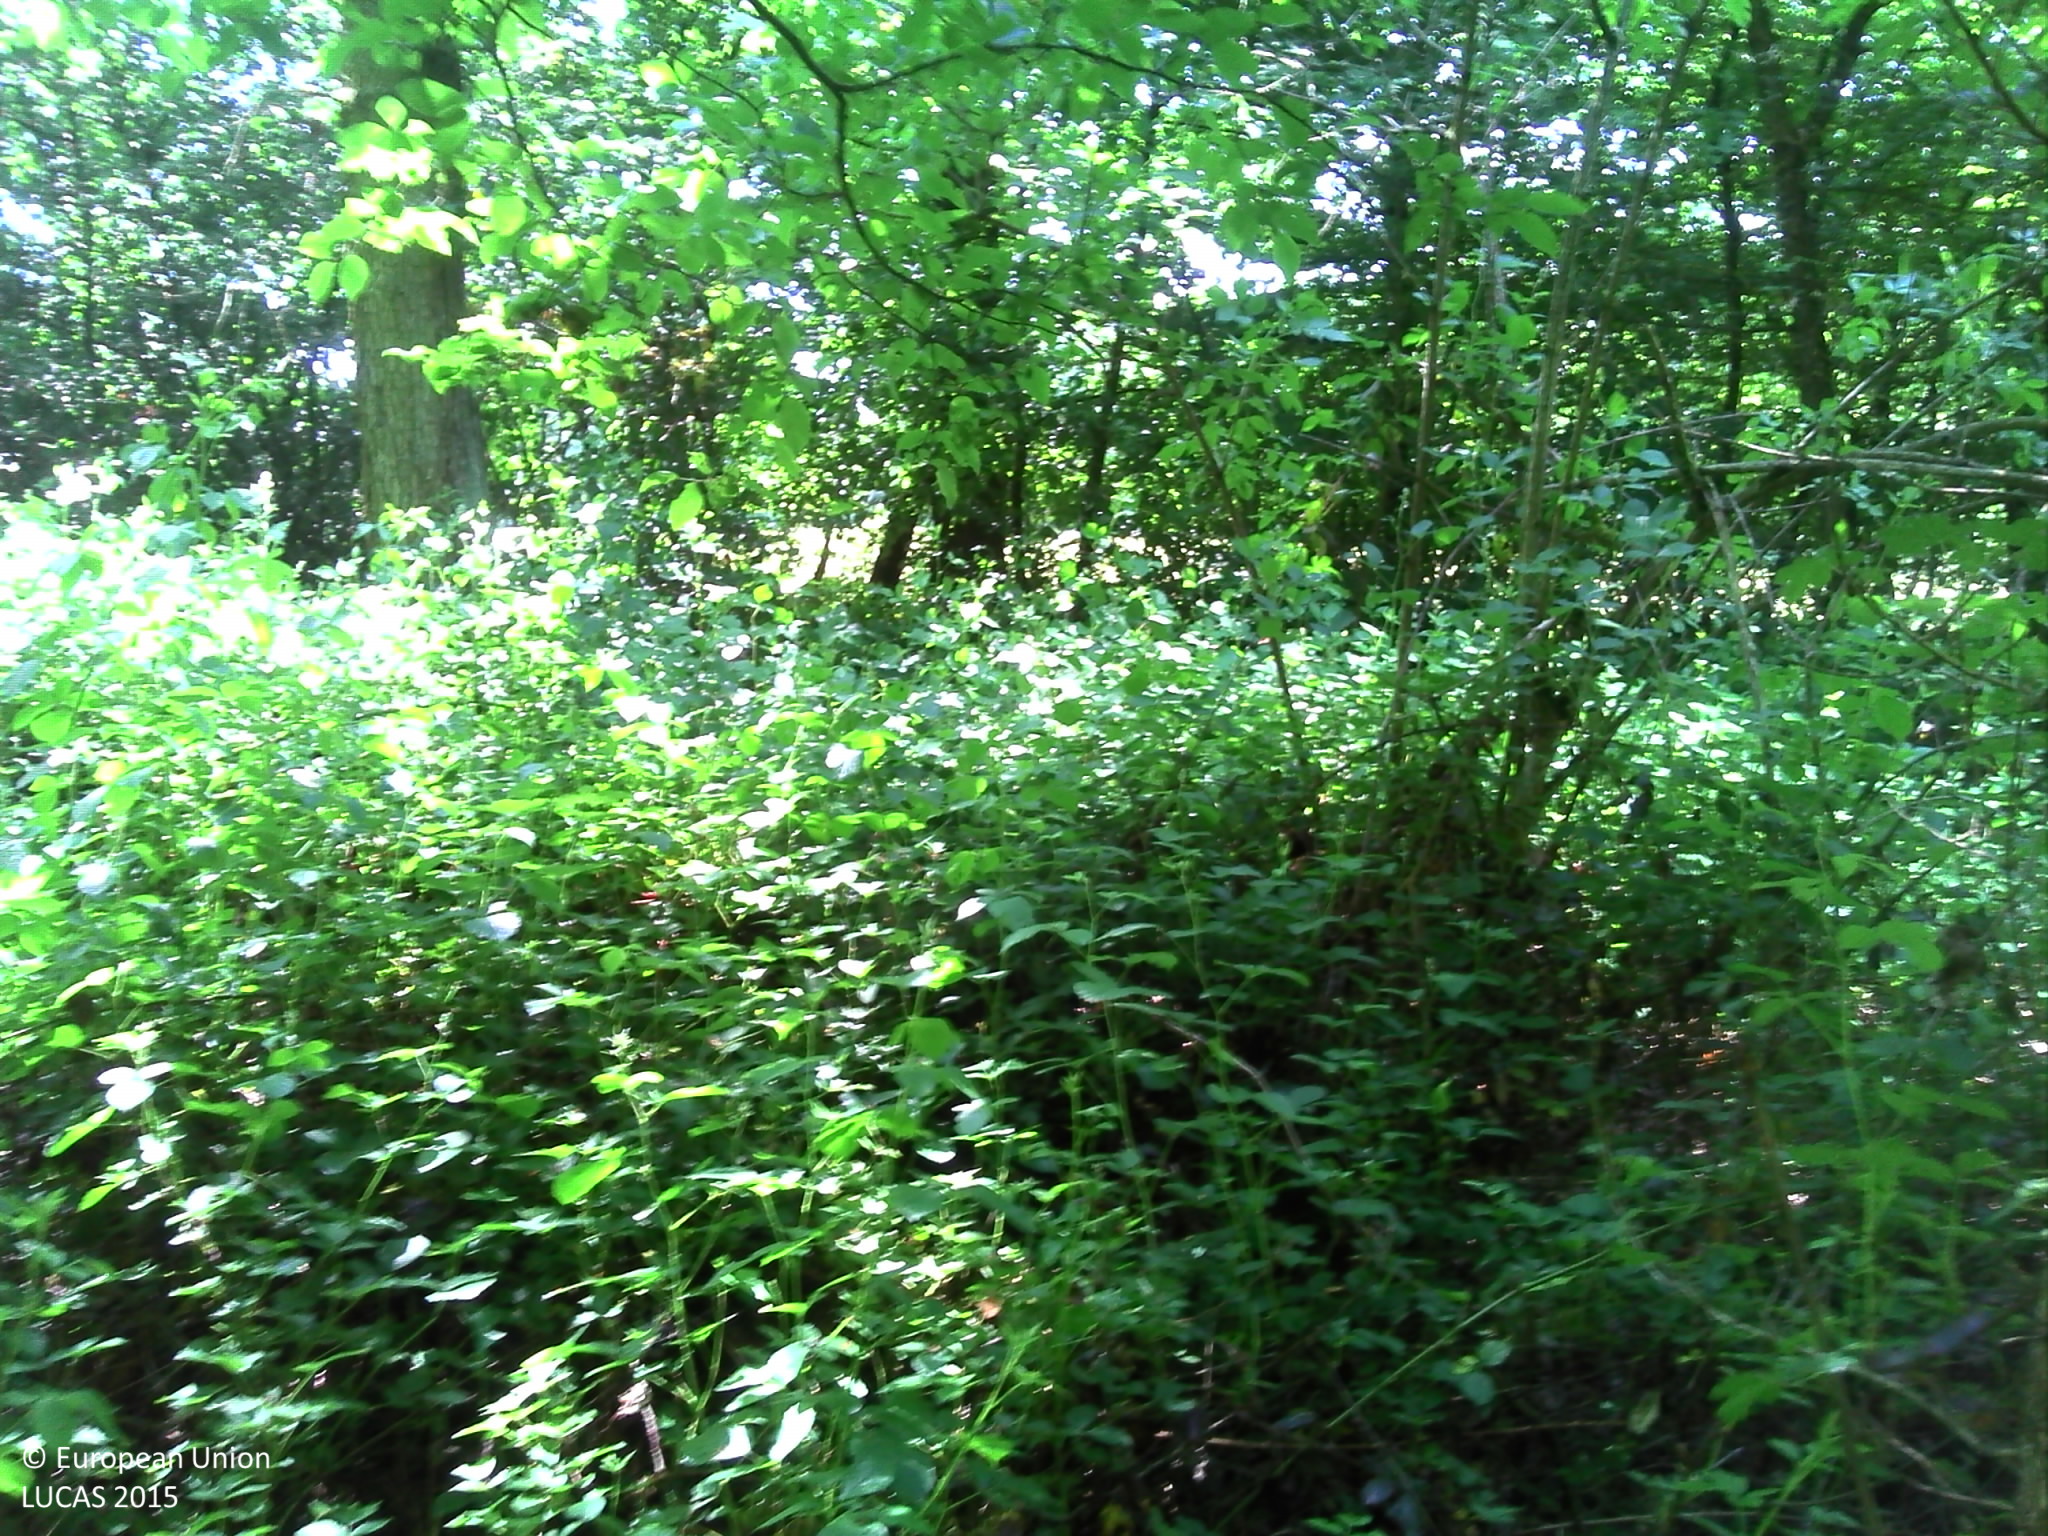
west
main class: Woodland
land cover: Broadleaved woodland
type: mesophytic deciduous forest
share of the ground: > 75 %
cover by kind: broadleaved forest trees 95 %, herbaceous plants 5 %
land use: Forestry
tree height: > 5 m
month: June
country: FR
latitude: 47.6895
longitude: 7.4302
